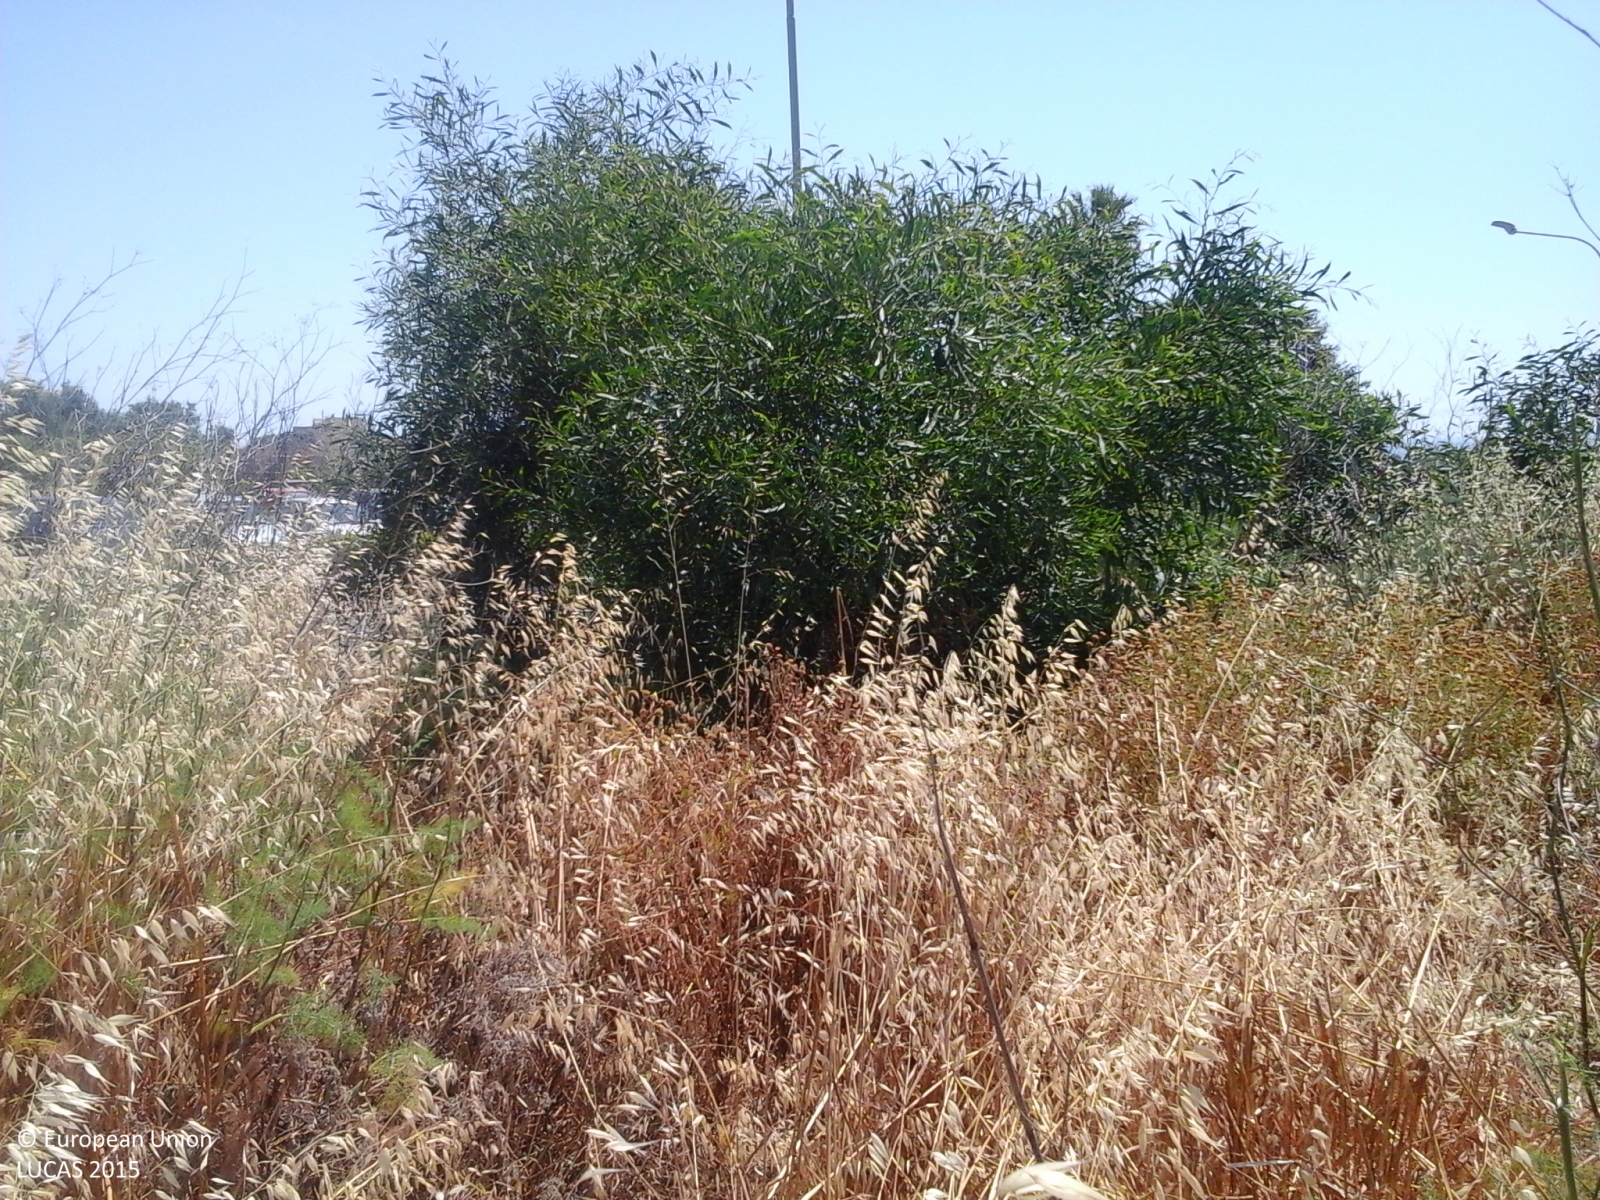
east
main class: Grassland
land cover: Grassland with sparse tree/shrub cover
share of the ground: > 75 %
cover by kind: herbaceous plants 95 %, coniferous forest trees 5 %
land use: Abandoned areas
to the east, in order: Grassland with sparse tree/shrub cover; Artificial constructions in urban areas; Spontaneously vegetated surfaces; Dry stone walls; Mixed cereals for fodder; Dry stone walls; Dry pulses; Triticale; Potatoes; Lines of trees; Dry stone walls; Artificial constructions in urban areas
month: May
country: MT
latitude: 35.8208
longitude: 14.5071
